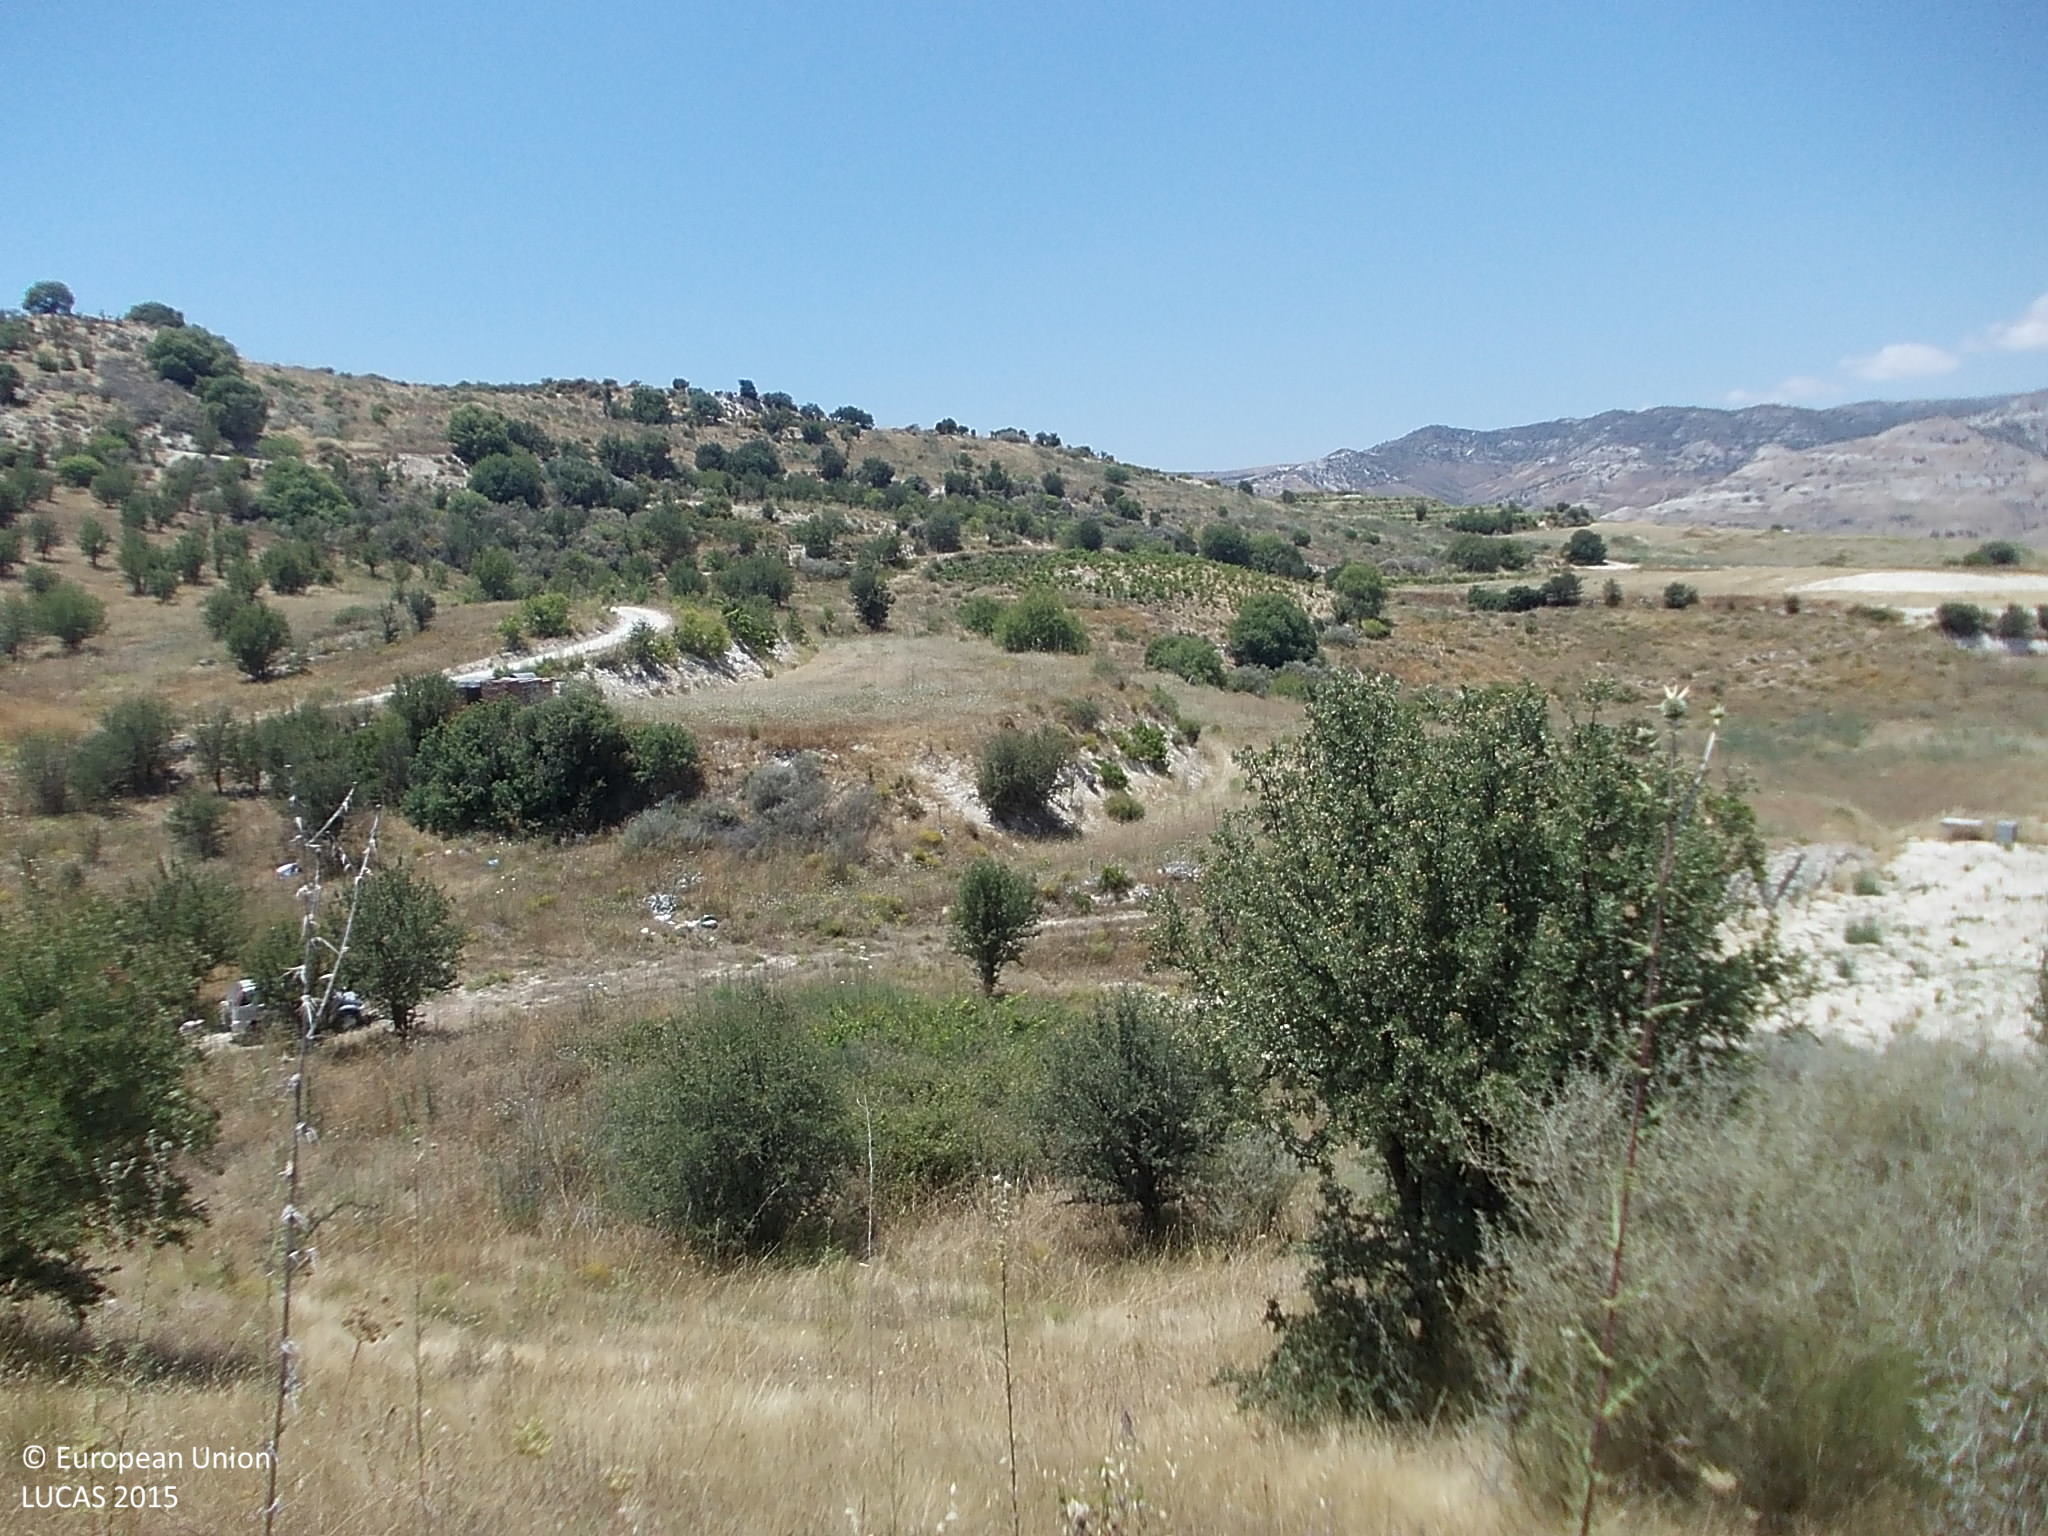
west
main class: Grassland
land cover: Grassland with sparse tree/shrub cover
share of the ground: > 75 %
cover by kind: herbaceous plants 85 %, broadleaved forest trees 5 %, shrubs 5 %, unconsolidated bare surface 5 %
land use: Semi-natural and natural areas not in use
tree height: < 5 m
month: July
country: CY
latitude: 34.8064
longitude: 32.7297
